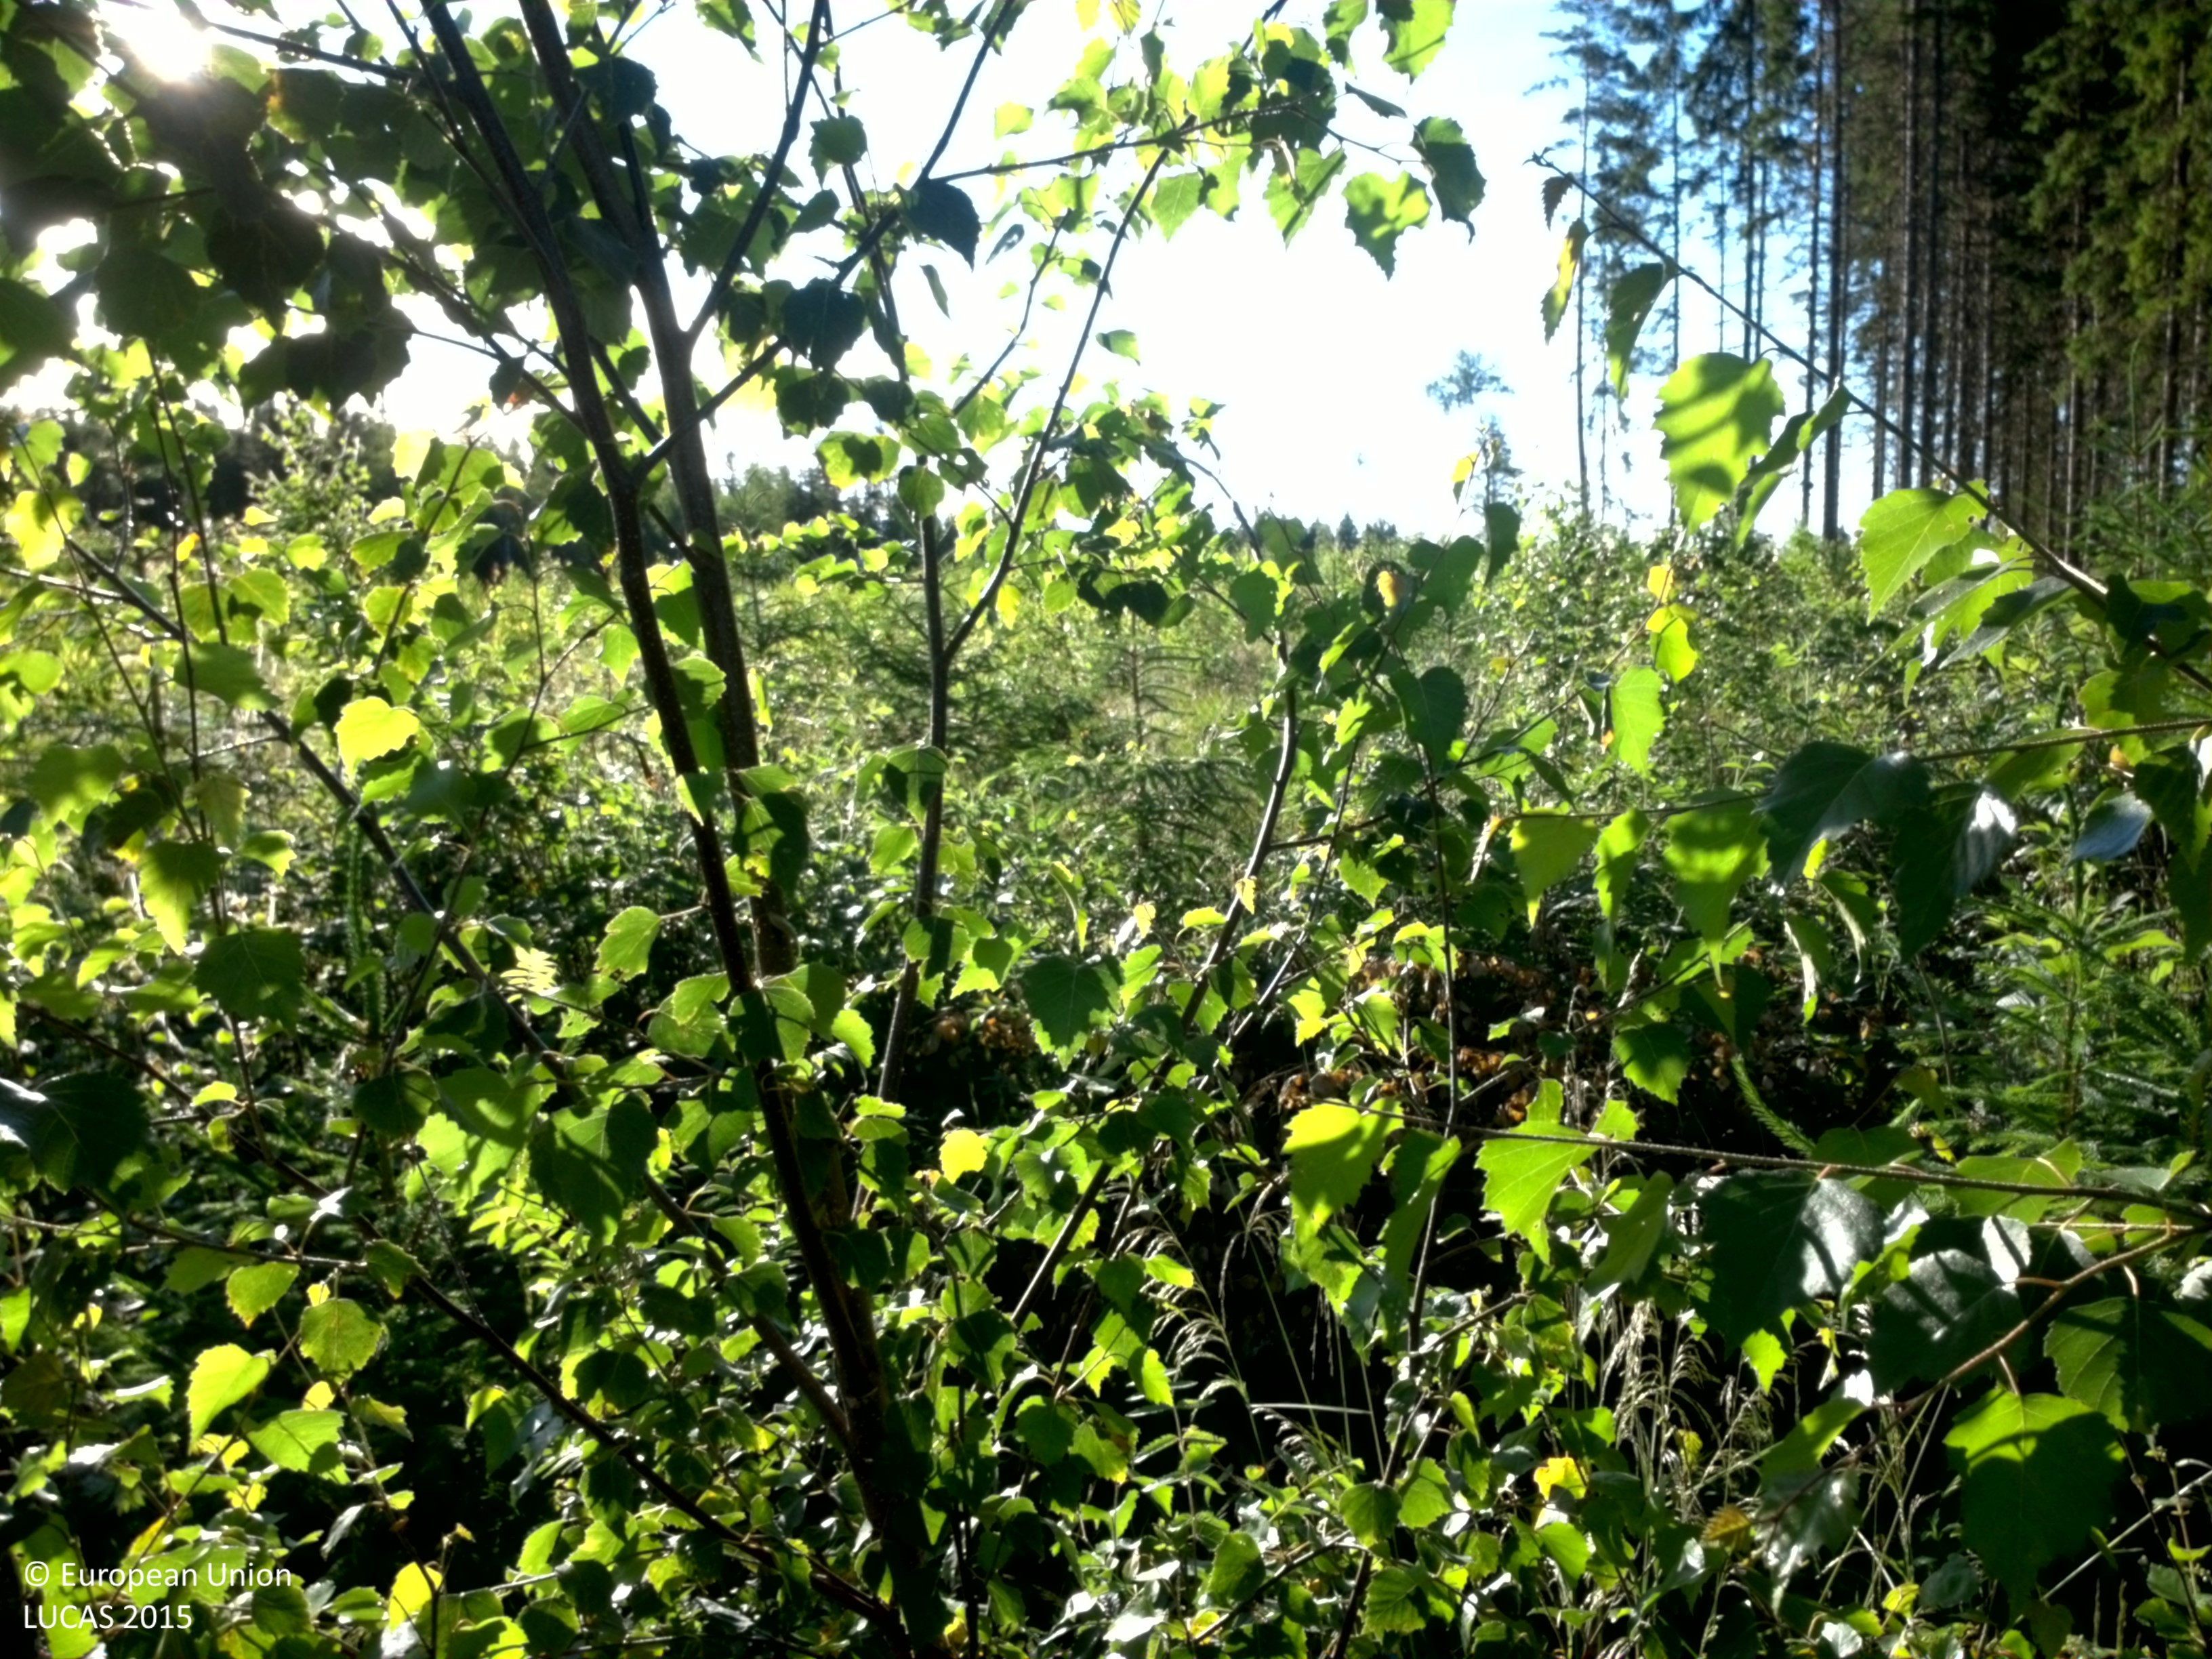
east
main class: Woodland
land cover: Spruce dominated mixed woodland
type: boreal forest
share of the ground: 25 - 50 %
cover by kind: coniferous forest trees 35 %, herbaceous plants 30 %, broadleaved forest trees 15 %, shrubs 5 %
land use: Forestry
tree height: < 5 m
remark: Clear cut
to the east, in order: Spruce dominated mixed woodland; Tracks; Spruce dominated mixed woodland
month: July
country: SE
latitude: 59.8720
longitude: 12.4046
